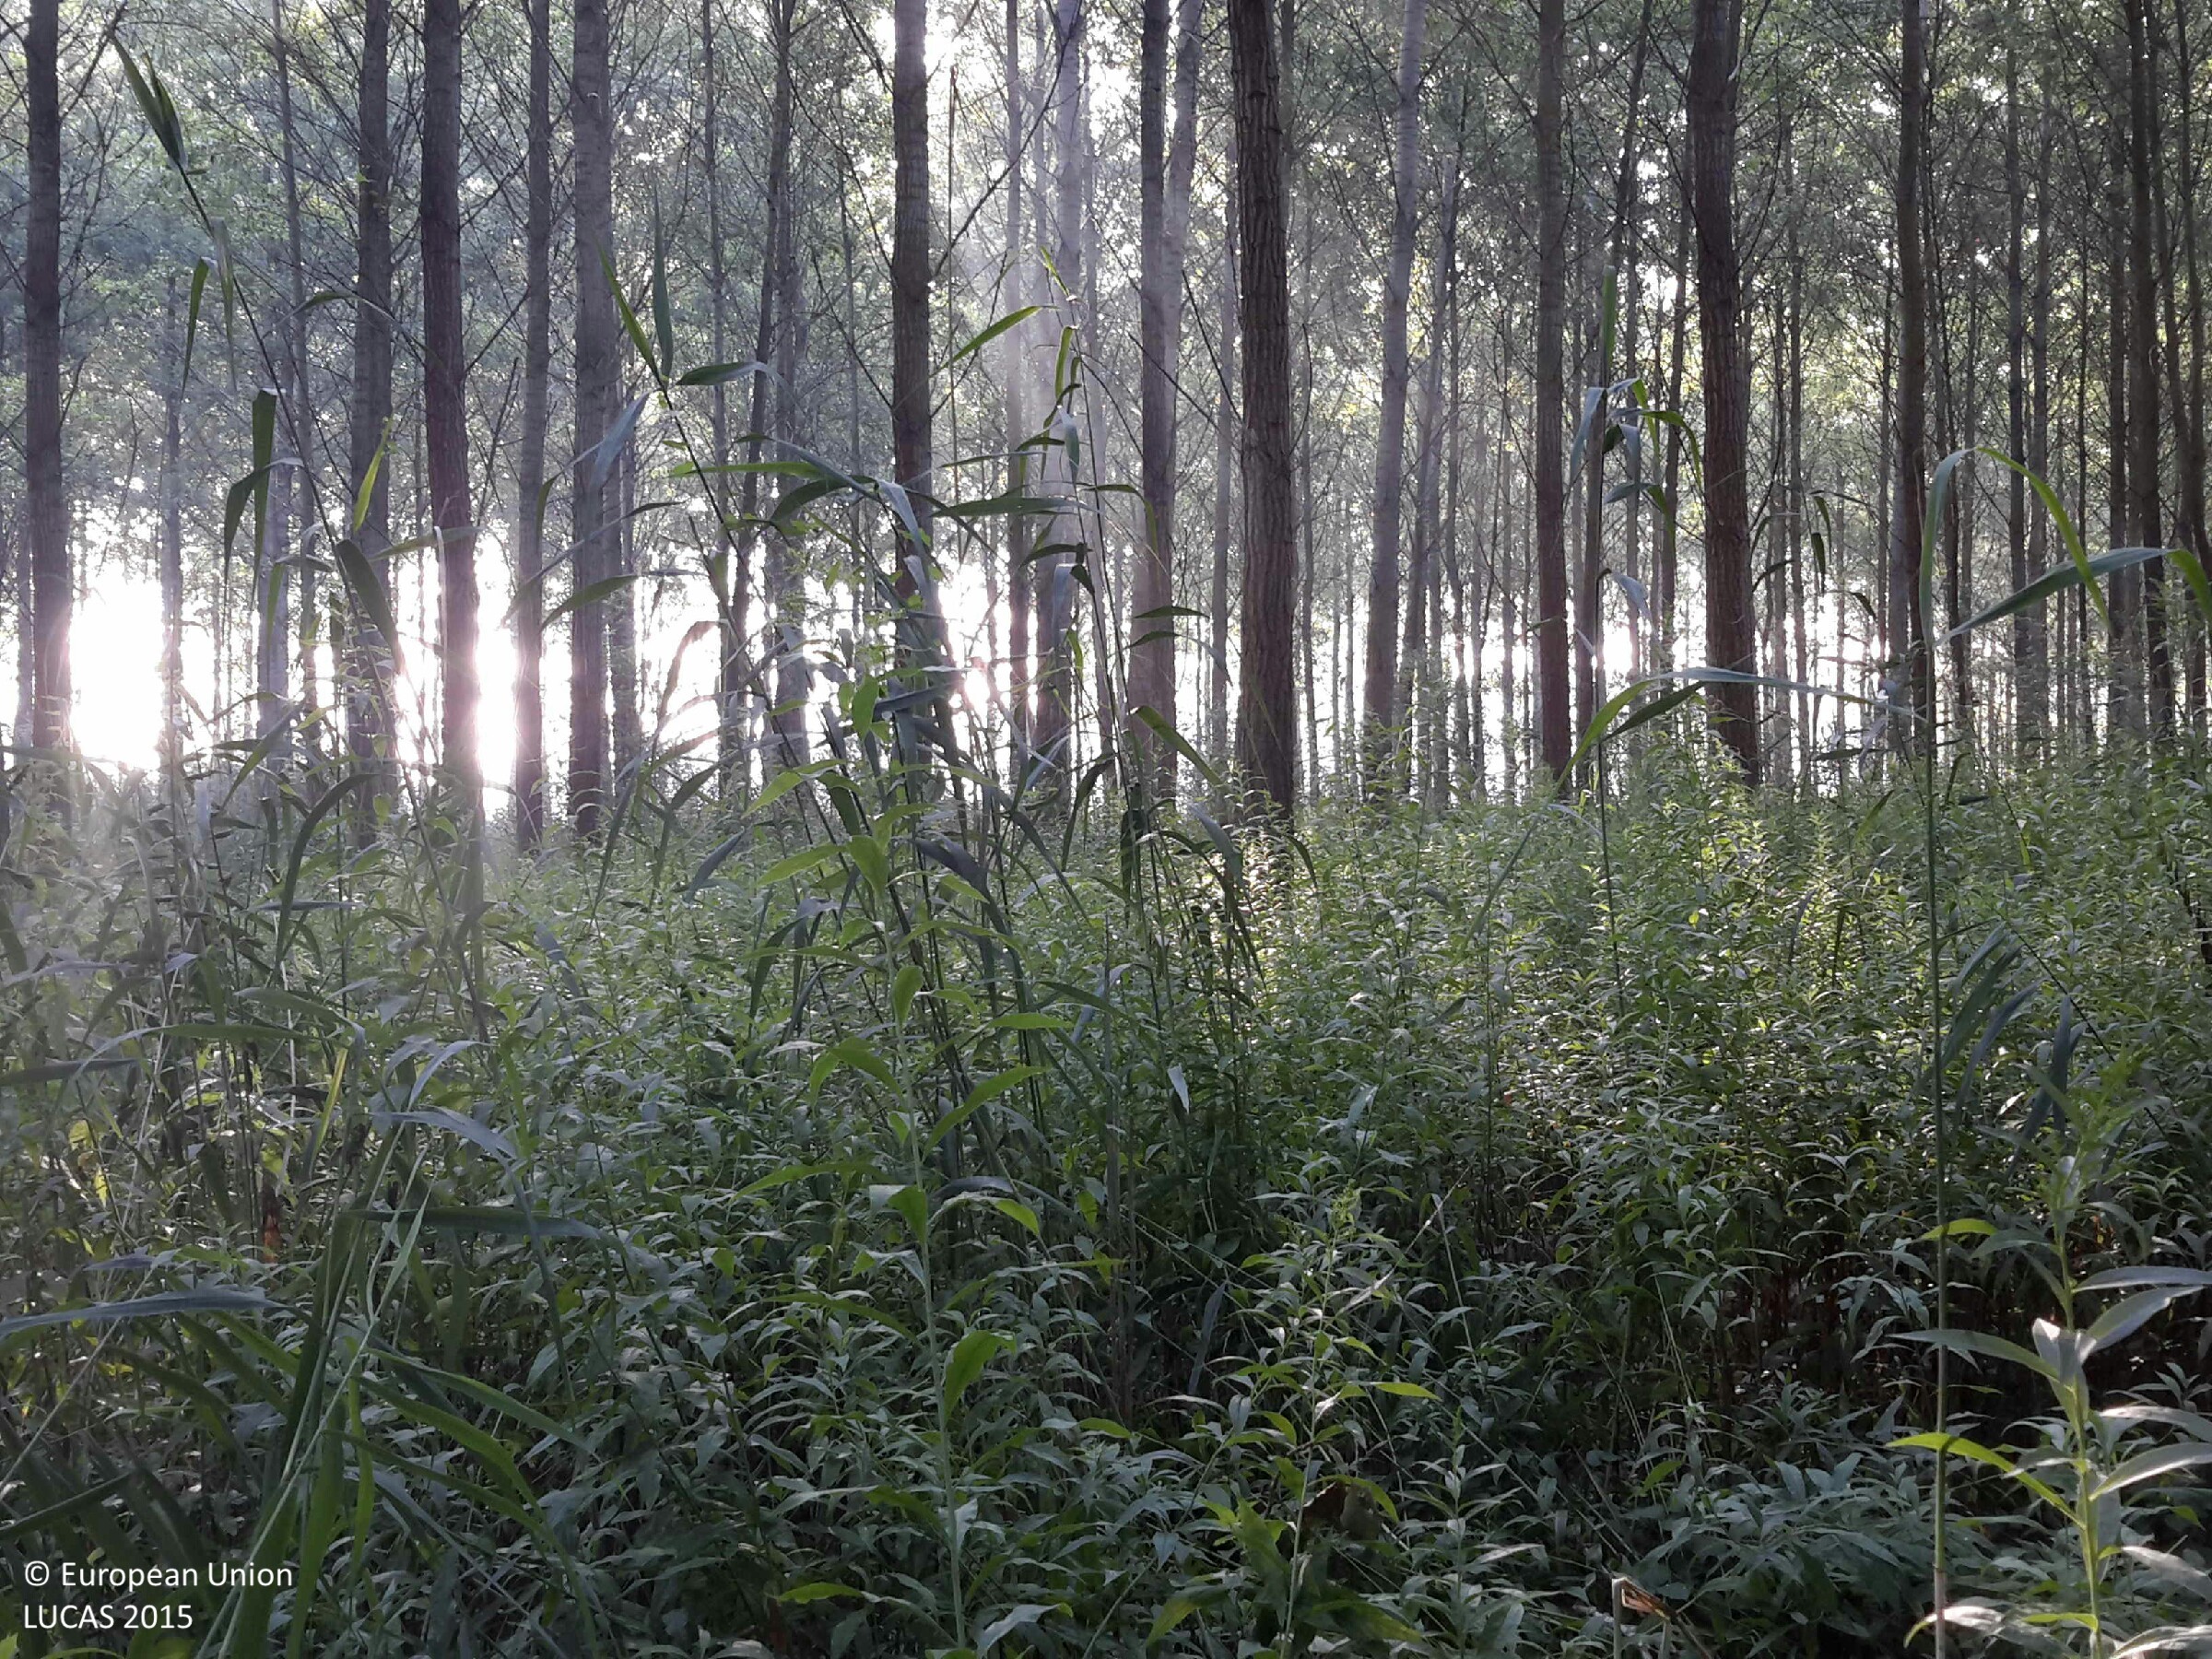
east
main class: Woodland
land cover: Broadleaved woodland
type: mesophytic deciduous forest
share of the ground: > 75 %
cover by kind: broadleaved forest trees 90 %, herbaceous plants 10 %
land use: Forestry
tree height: > 5 m
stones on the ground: < 10 %
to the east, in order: Broadleaved woodland; Spontaneously vegetated surfaces; Tracks; Spontaneously vegetated surfaces; Shruby margins; Grassland without tree/shrub cover
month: August
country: HU
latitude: 47.7301
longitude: 17.2743
